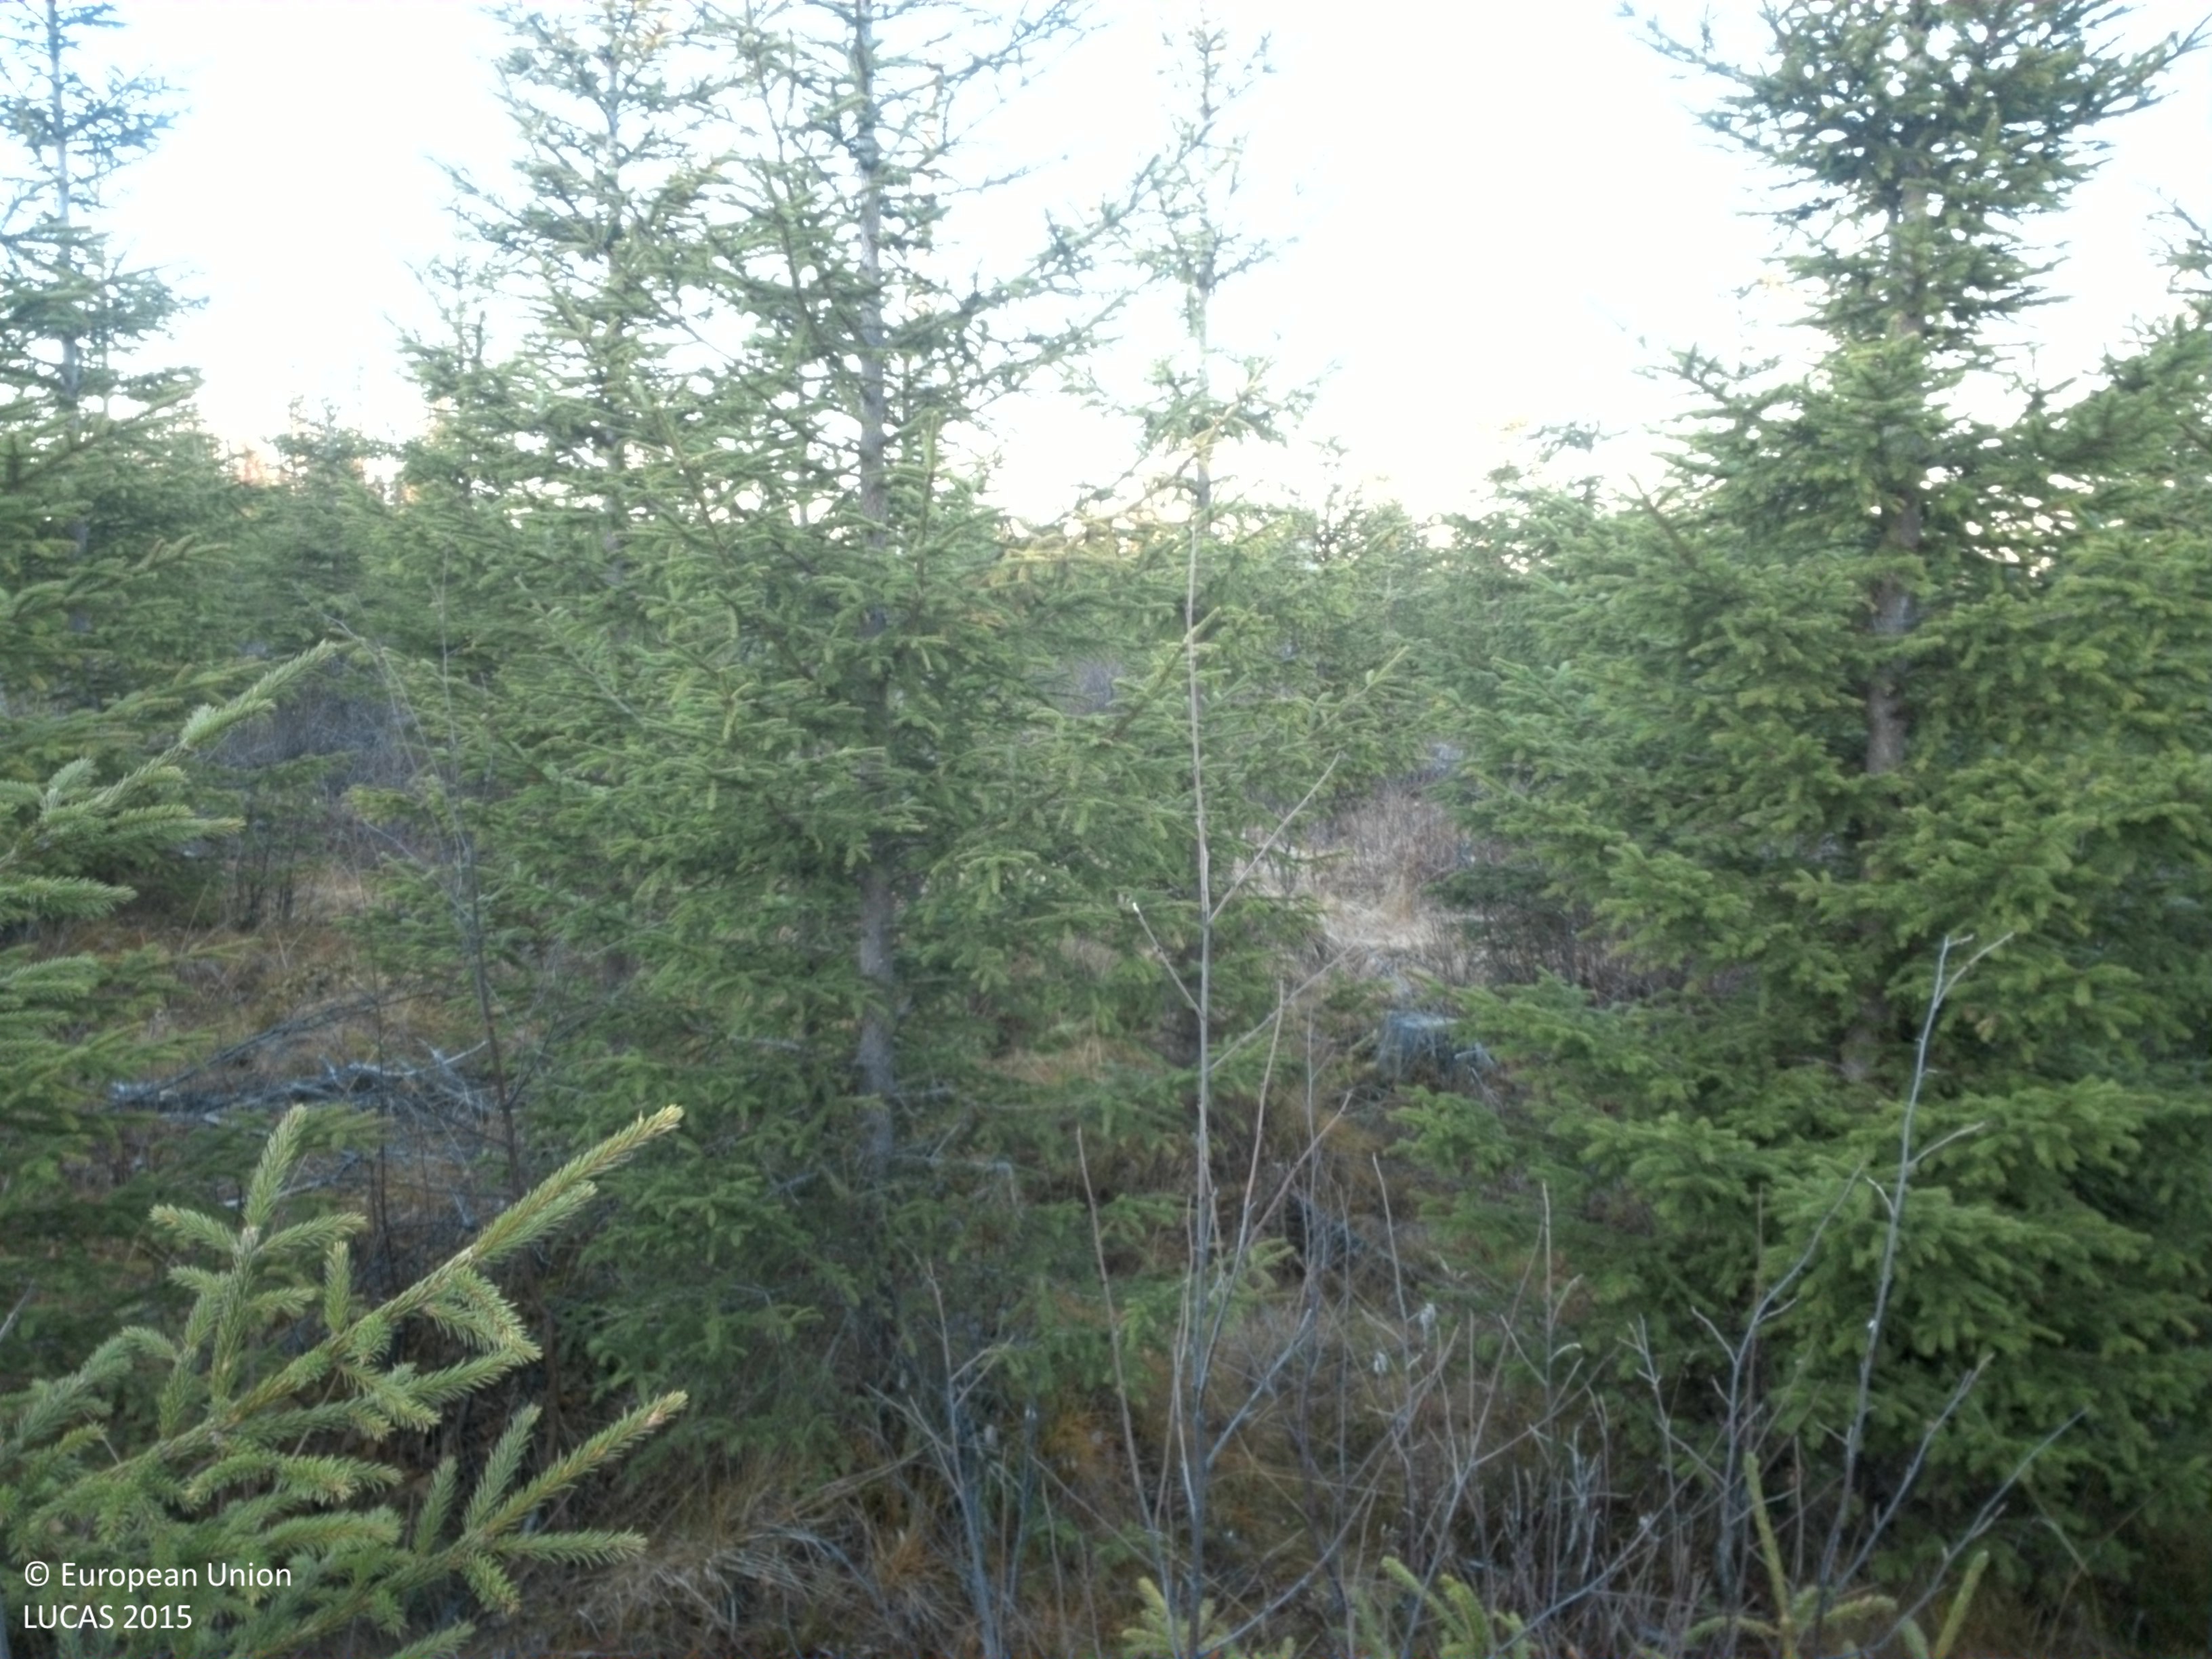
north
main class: Woodland
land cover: Spruce dominated coniferous woodland
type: boreal forest
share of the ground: 25 - 50 %
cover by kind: shrubs 35 %, herbaceous plants 35 %, coniferous forest trees 20 %, broadleaved forest trees 5 %, lichens and mosses 5 %
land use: Forestry
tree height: < 5 m
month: October
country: SE
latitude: 64.5055
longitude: 16.8181
